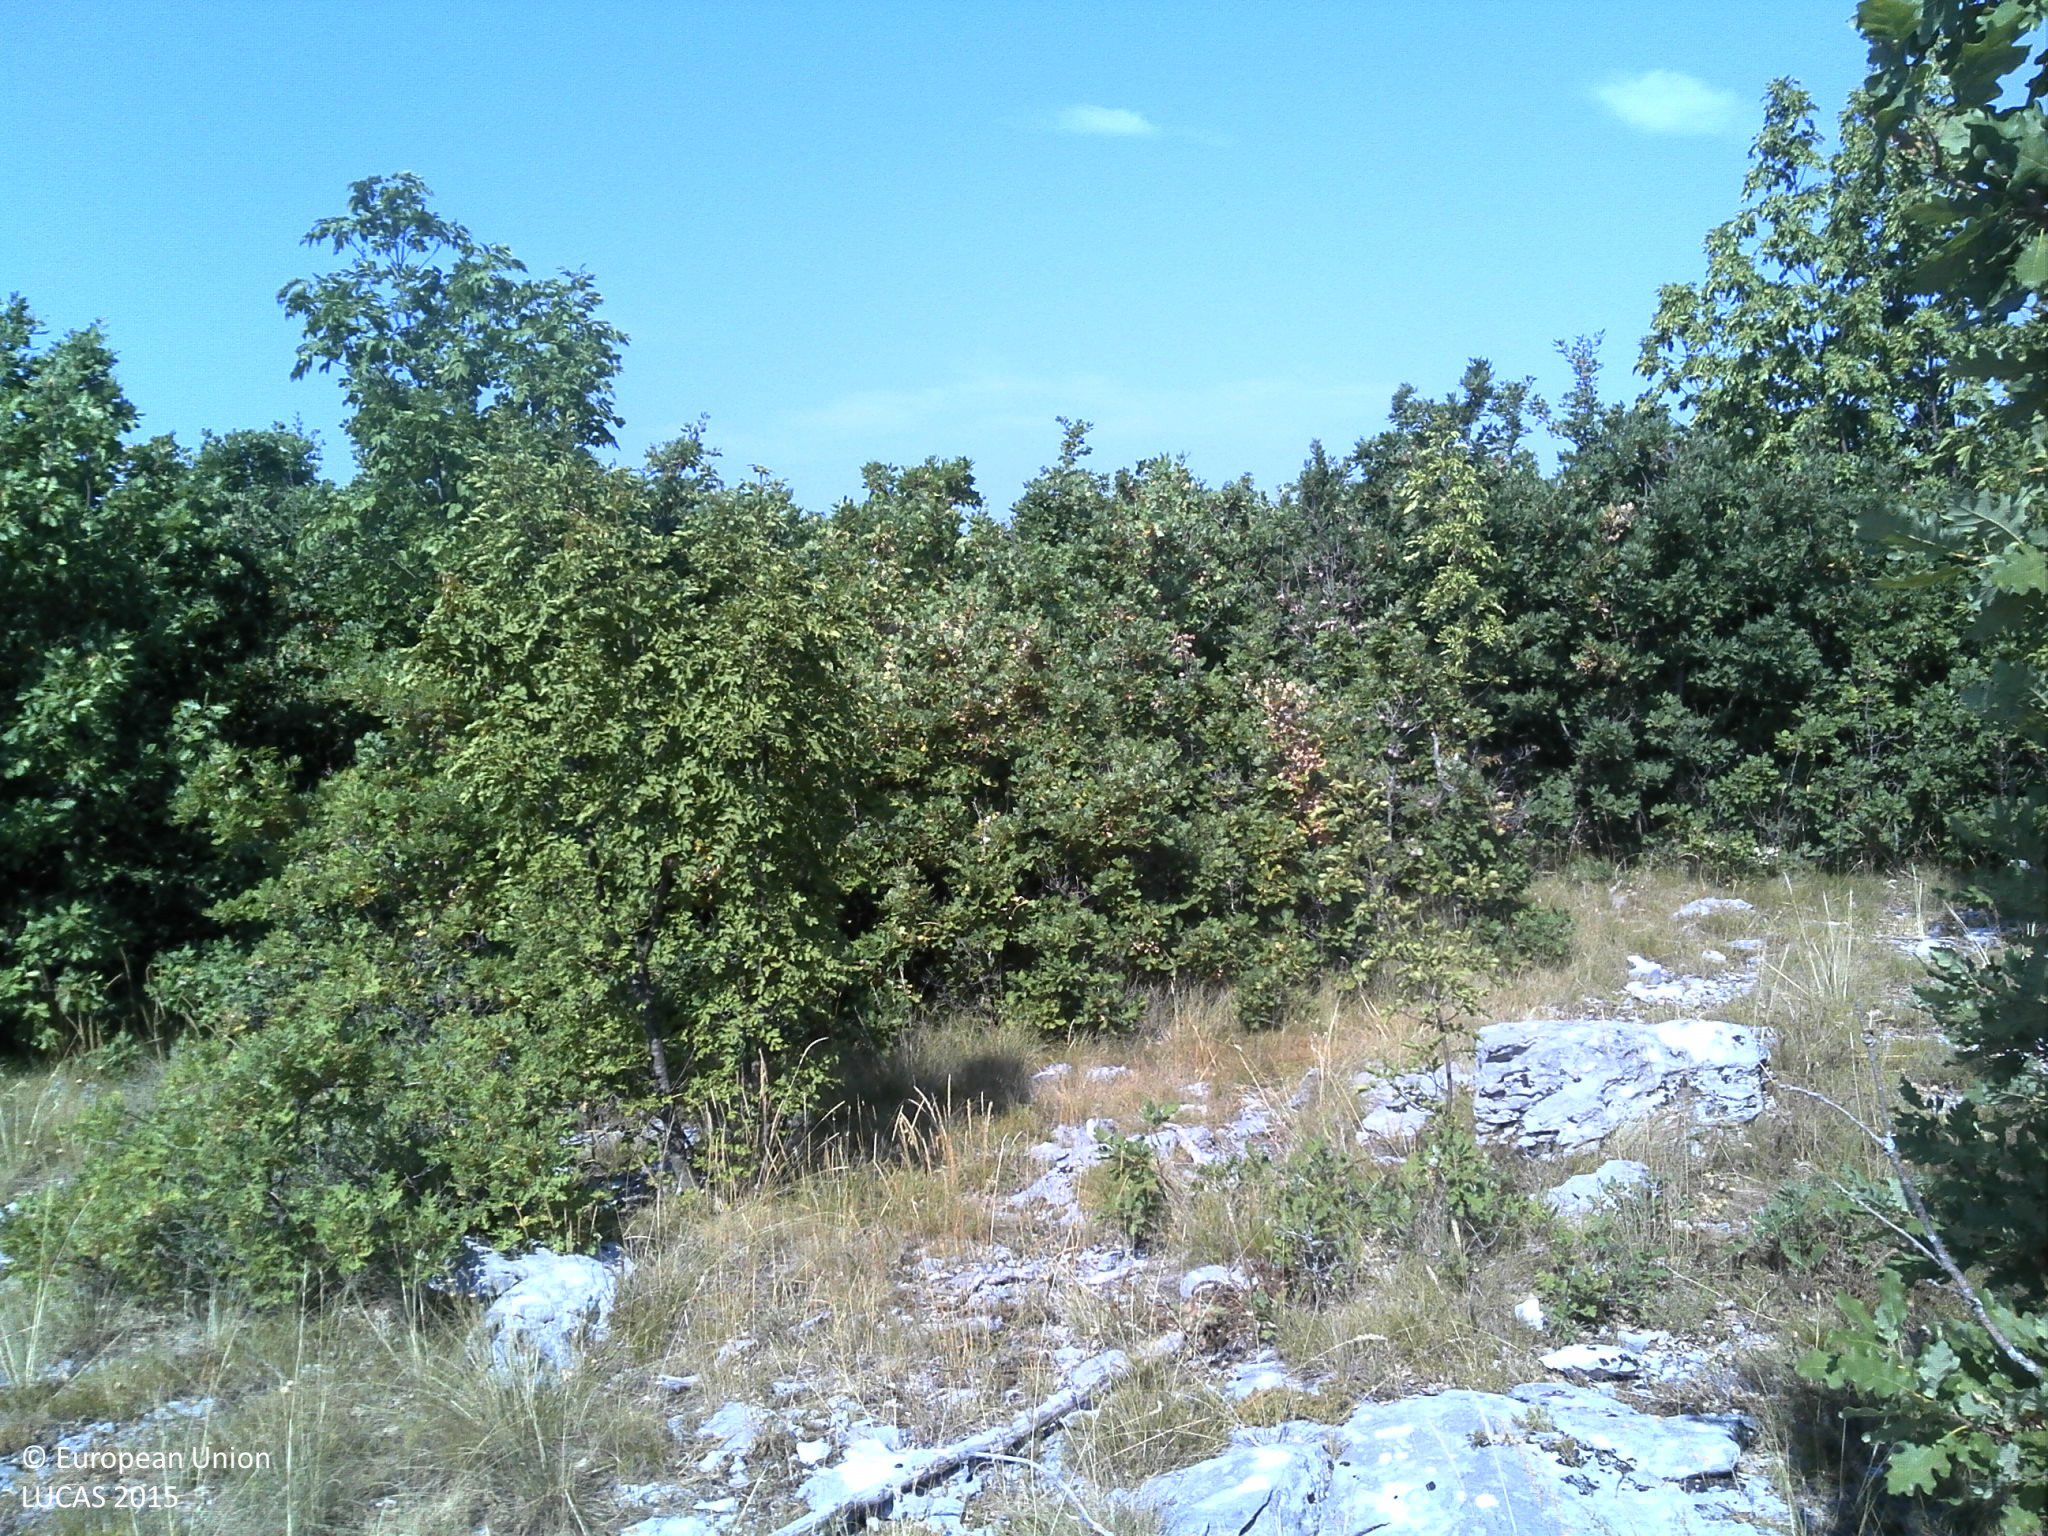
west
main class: Woodland
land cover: Broadleaved woodland
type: thermophilous deciduous forest
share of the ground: 50 - 75 %
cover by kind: broadleaved forest trees 55 %, consolidated bare surface 20 %, shrubs 15 %, herbaceous plants 10 %
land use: Semi-natural and natural areas not in use
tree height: > 5 m
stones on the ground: 10 - 25 %
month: July
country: HR
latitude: 43.5947
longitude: 16.9162
